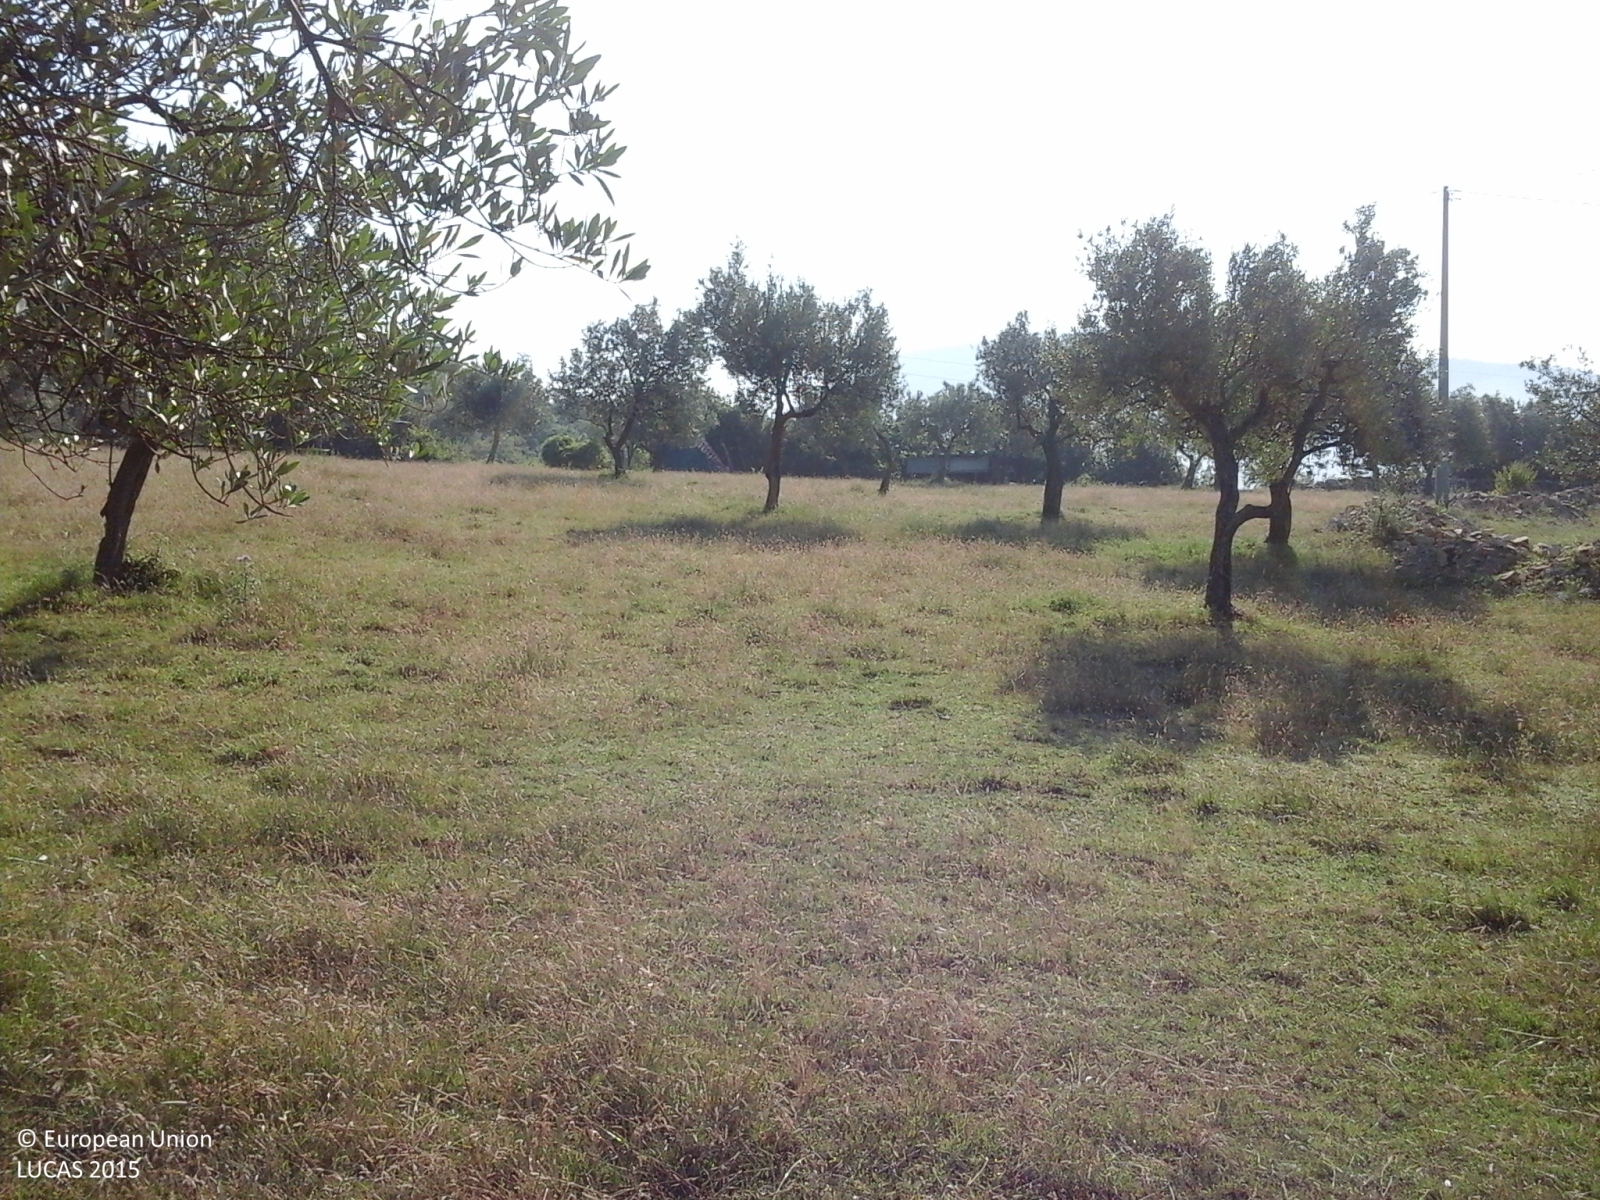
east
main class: Cropland
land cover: Olive groves
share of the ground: 25 - 50 %
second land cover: Grassland without tree/shrub cover
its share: > 75 %
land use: Agriculture (excluding fallow land and kitchen gardens)
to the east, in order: Olive groves; Grassland without tree/shrub cover; Electric lines; Olive groves; Grassland without tree/shrub cover; Dry stone walls; Shrubland without tree cover; Dry stone walls; Grassland without tree/shrub cover; Olive groves; Broadleaved woodland; Electric lines; Broadleaved woodland
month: June
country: IT
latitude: 43.9109
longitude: 11.1800
